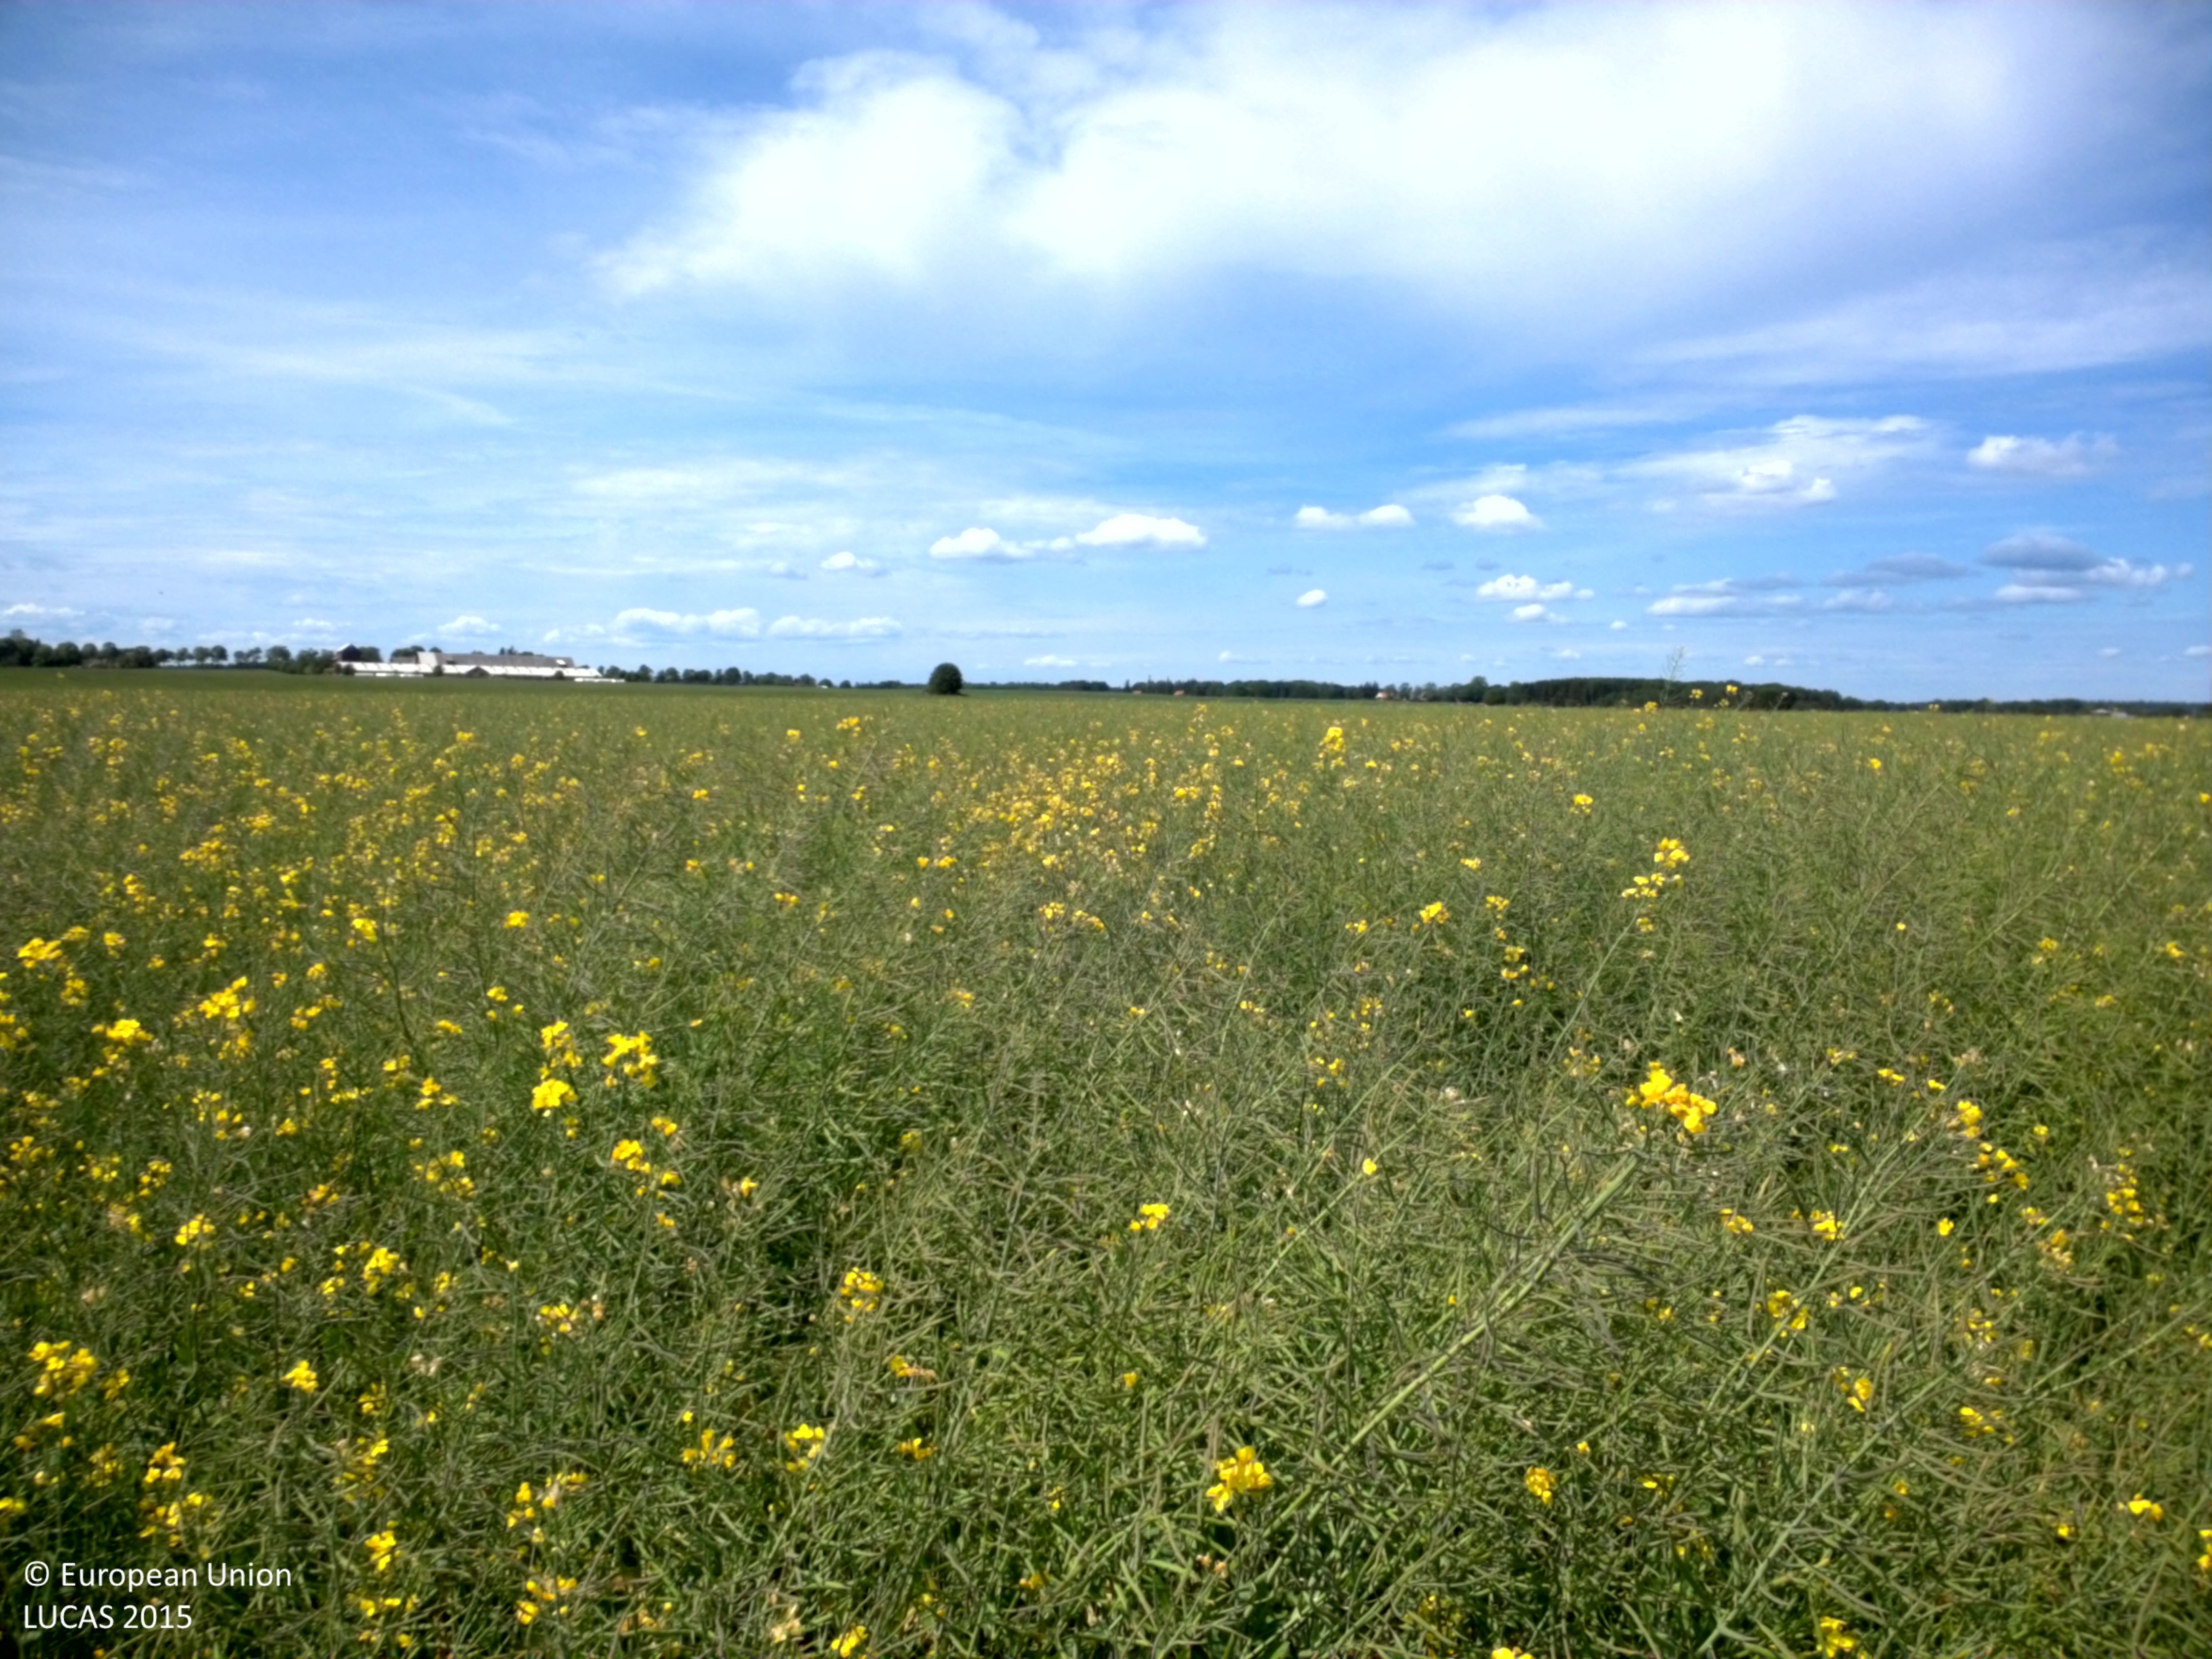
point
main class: Cropland
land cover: Rape and turnip rape
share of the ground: > 75 %
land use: Agriculture (excluding fallow land and kitchen gardens)
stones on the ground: < 10 %
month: June
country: SE
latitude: 58.5064
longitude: 15.4345
